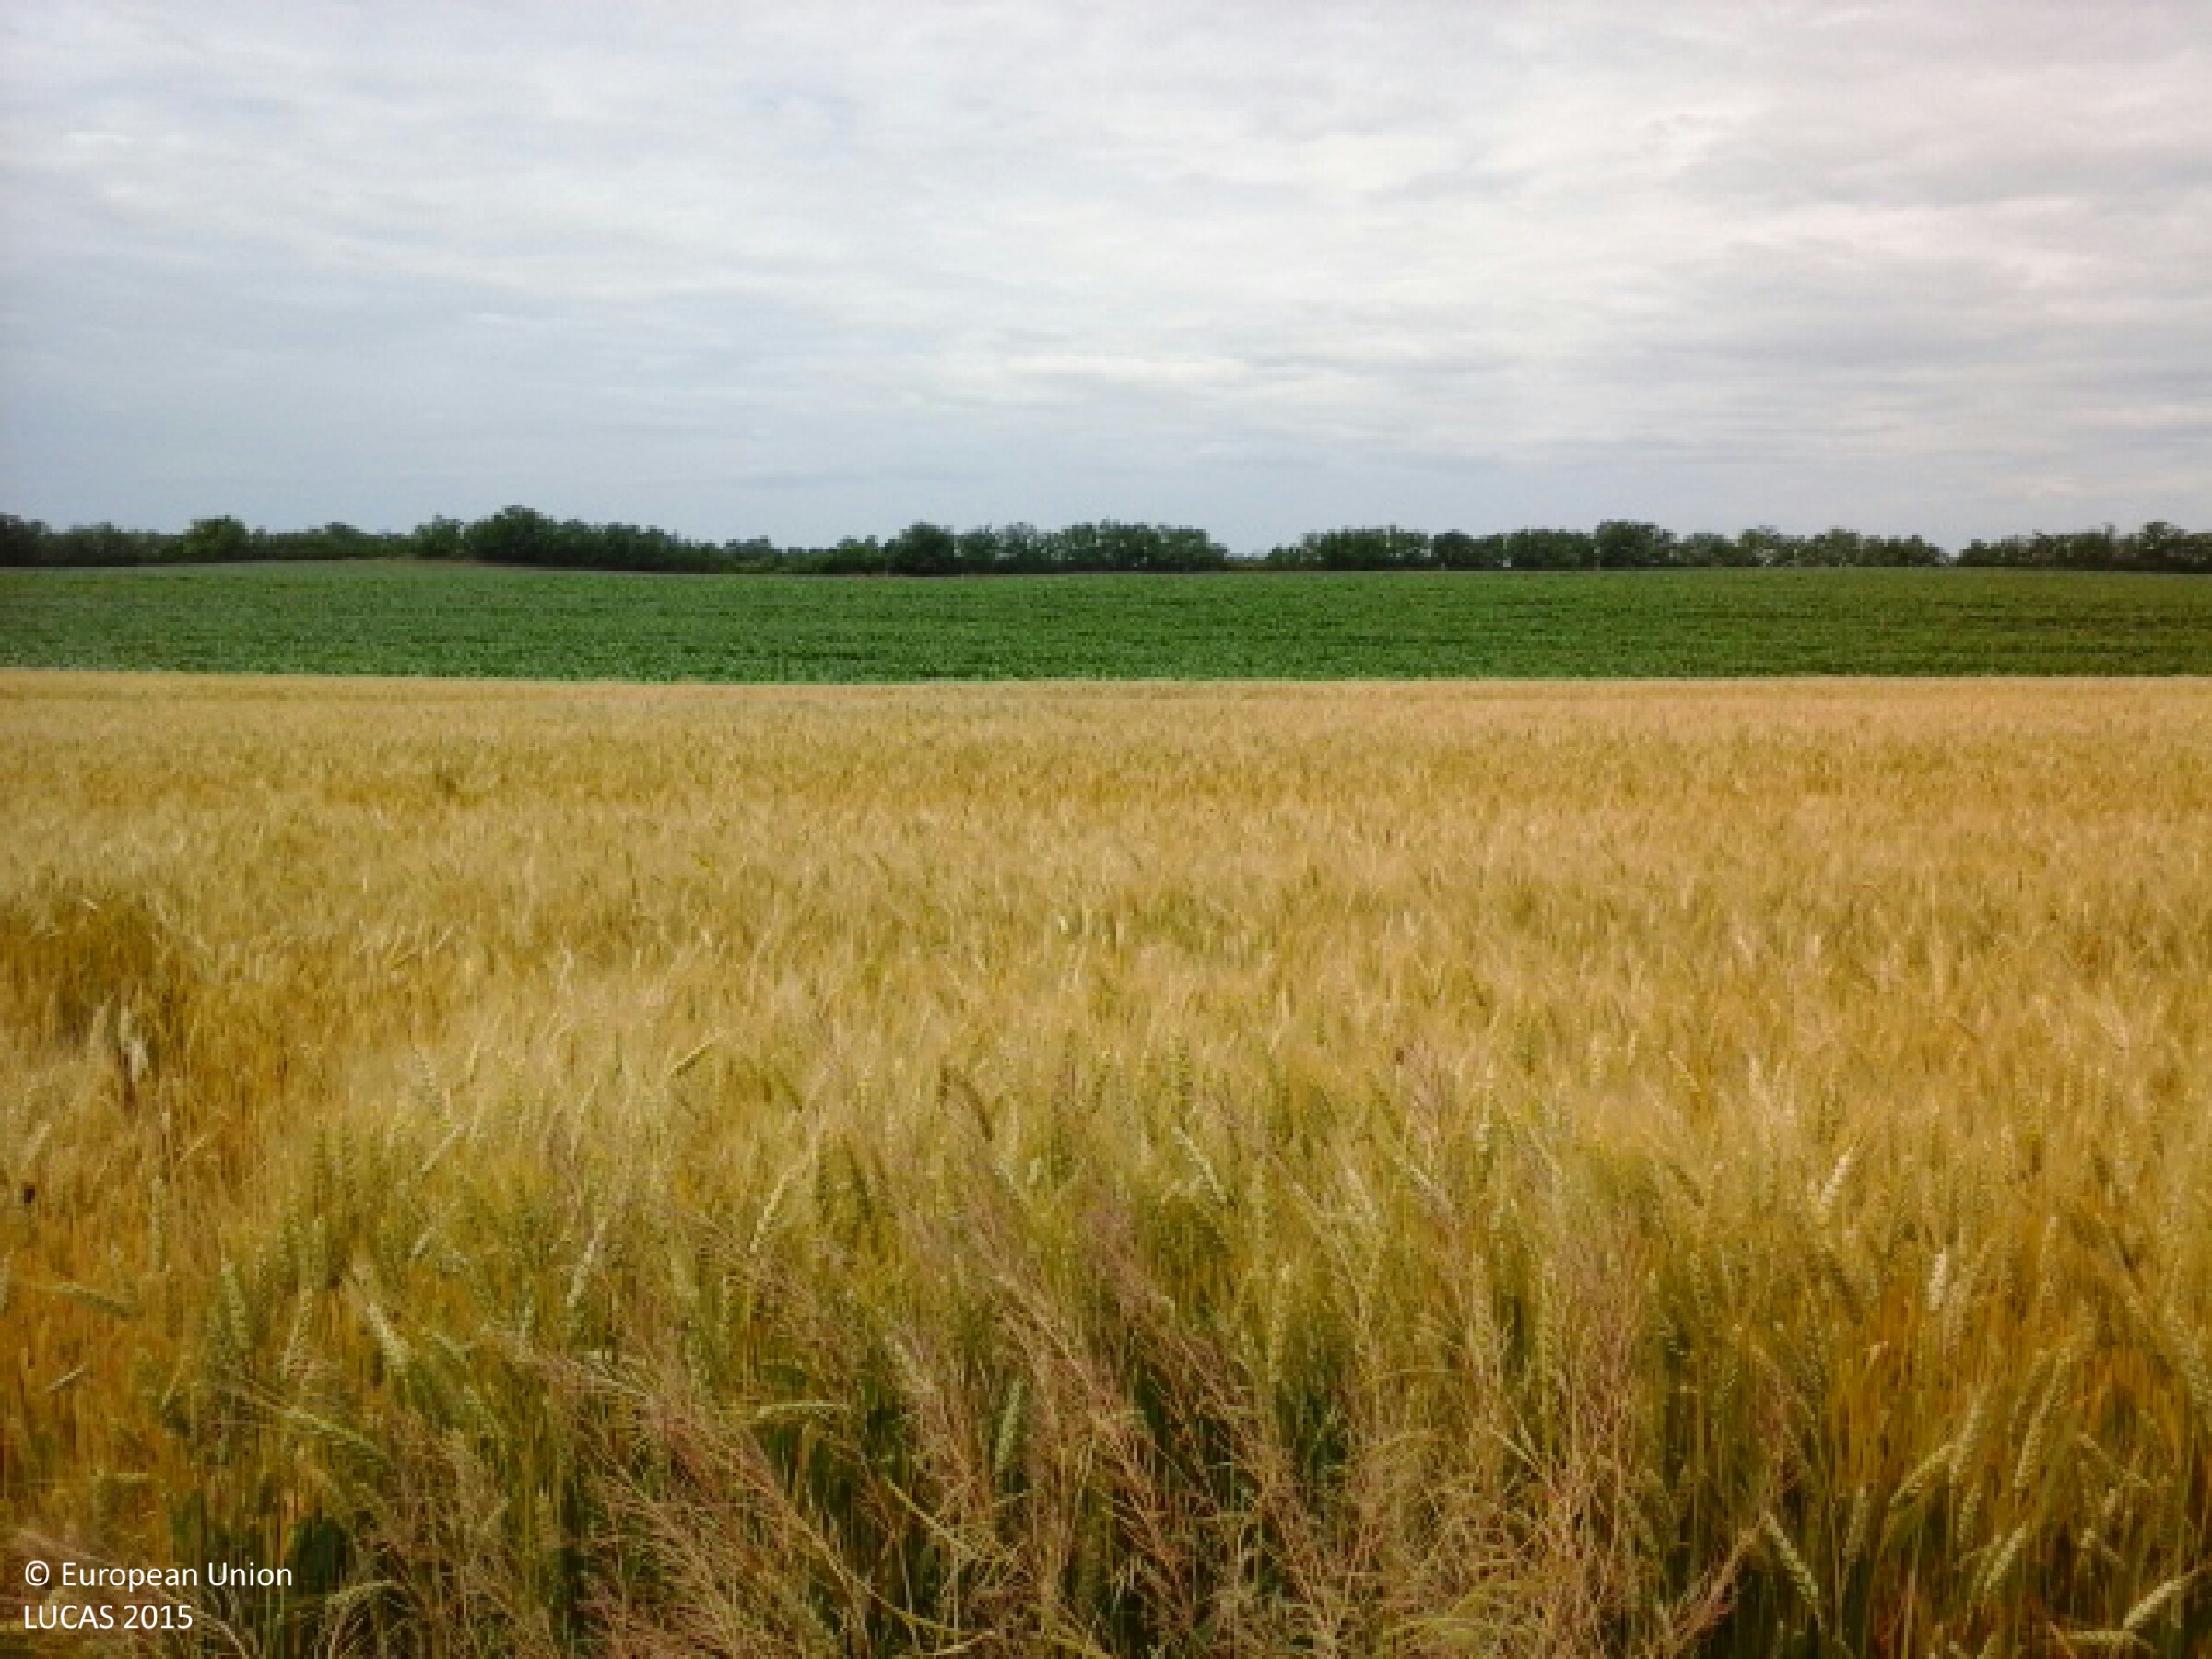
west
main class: Cropland
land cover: Rape and turnip rape
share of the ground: > 75 %
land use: Agriculture (excluding fallow land and kitchen gardens)
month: June
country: HU
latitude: 47.9801
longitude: 21.5270
